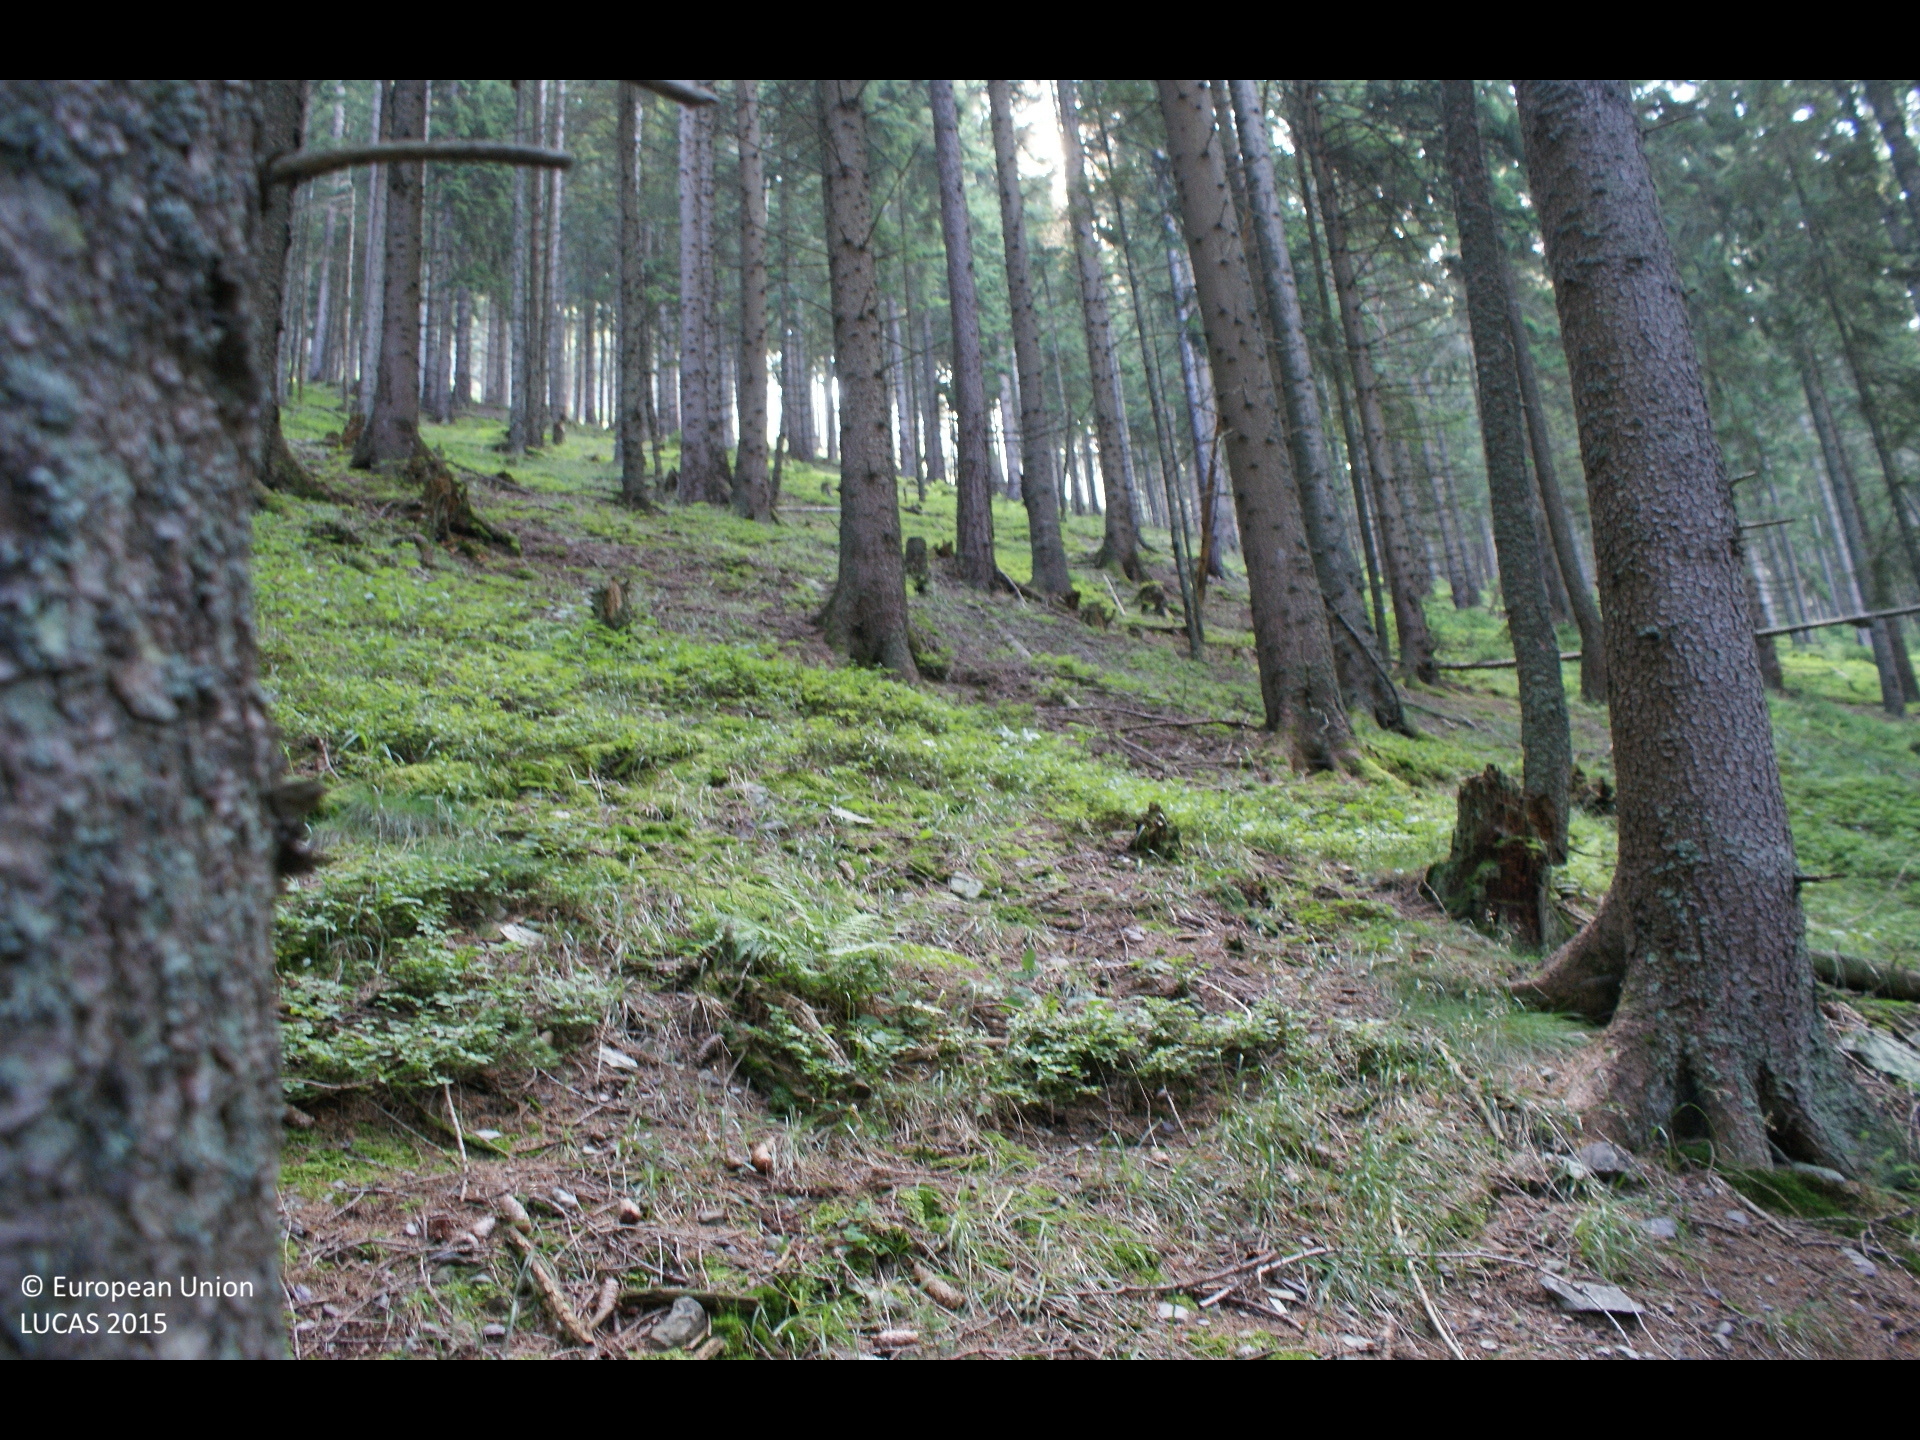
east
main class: Woodland
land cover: Spruce dominated coniferous woodland
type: alpine coniferous forest
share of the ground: > 75 %
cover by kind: coniferous forest trees 85 %, shrubs 5 %, herbaceous plants 5 %, lichens and mosses 5 %
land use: Forestry
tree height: > 5 m
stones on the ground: > 50 %
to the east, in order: Spruce dominated coniferous woodland; Grassland without tree/shrub cover; Tracks; Spruce dominated coniferous woodland
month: August
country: AT
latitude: 47.6446
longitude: 15.3122
